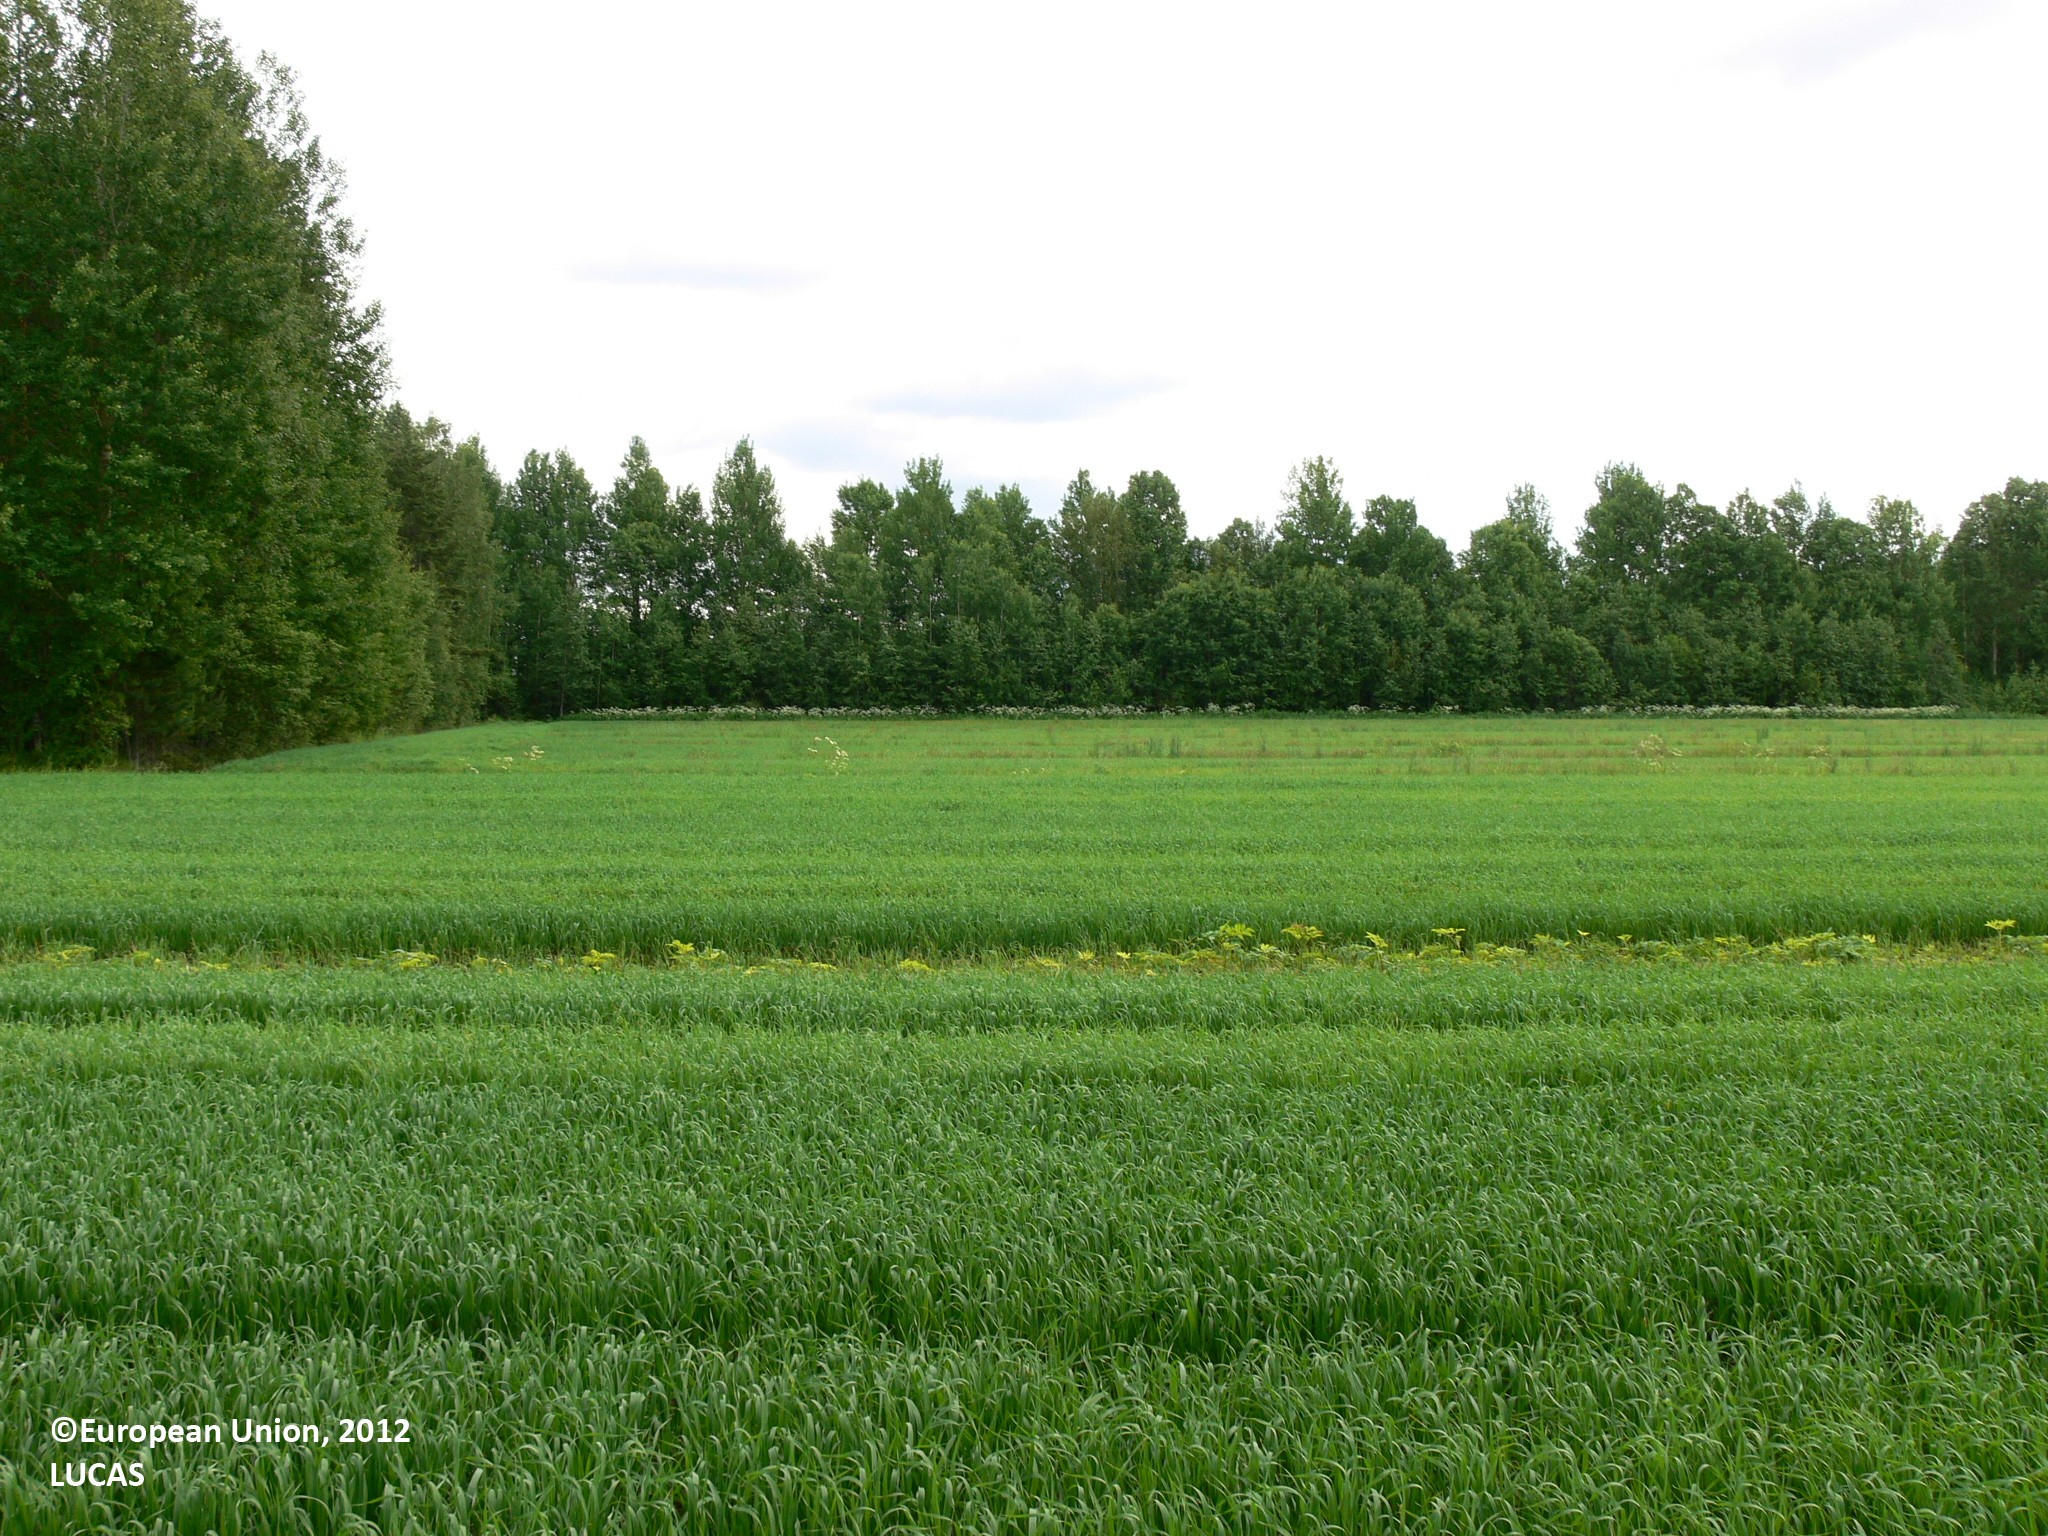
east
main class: Cropland
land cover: Oats
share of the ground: > 75 %
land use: Agriculture (excluding fallow land and kitchen gardens)
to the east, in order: Oats; Ditches and canals; Oats; Ditches and canals; Oats; Ditches and canals; Oats; Ditches and canals; Oats; Ditches and canals; Oats; Ditches and canals; Broadleaved woodland; Electric lines; Broadleaved woodland
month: June
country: FI
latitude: 62.6002
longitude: 29.5427
